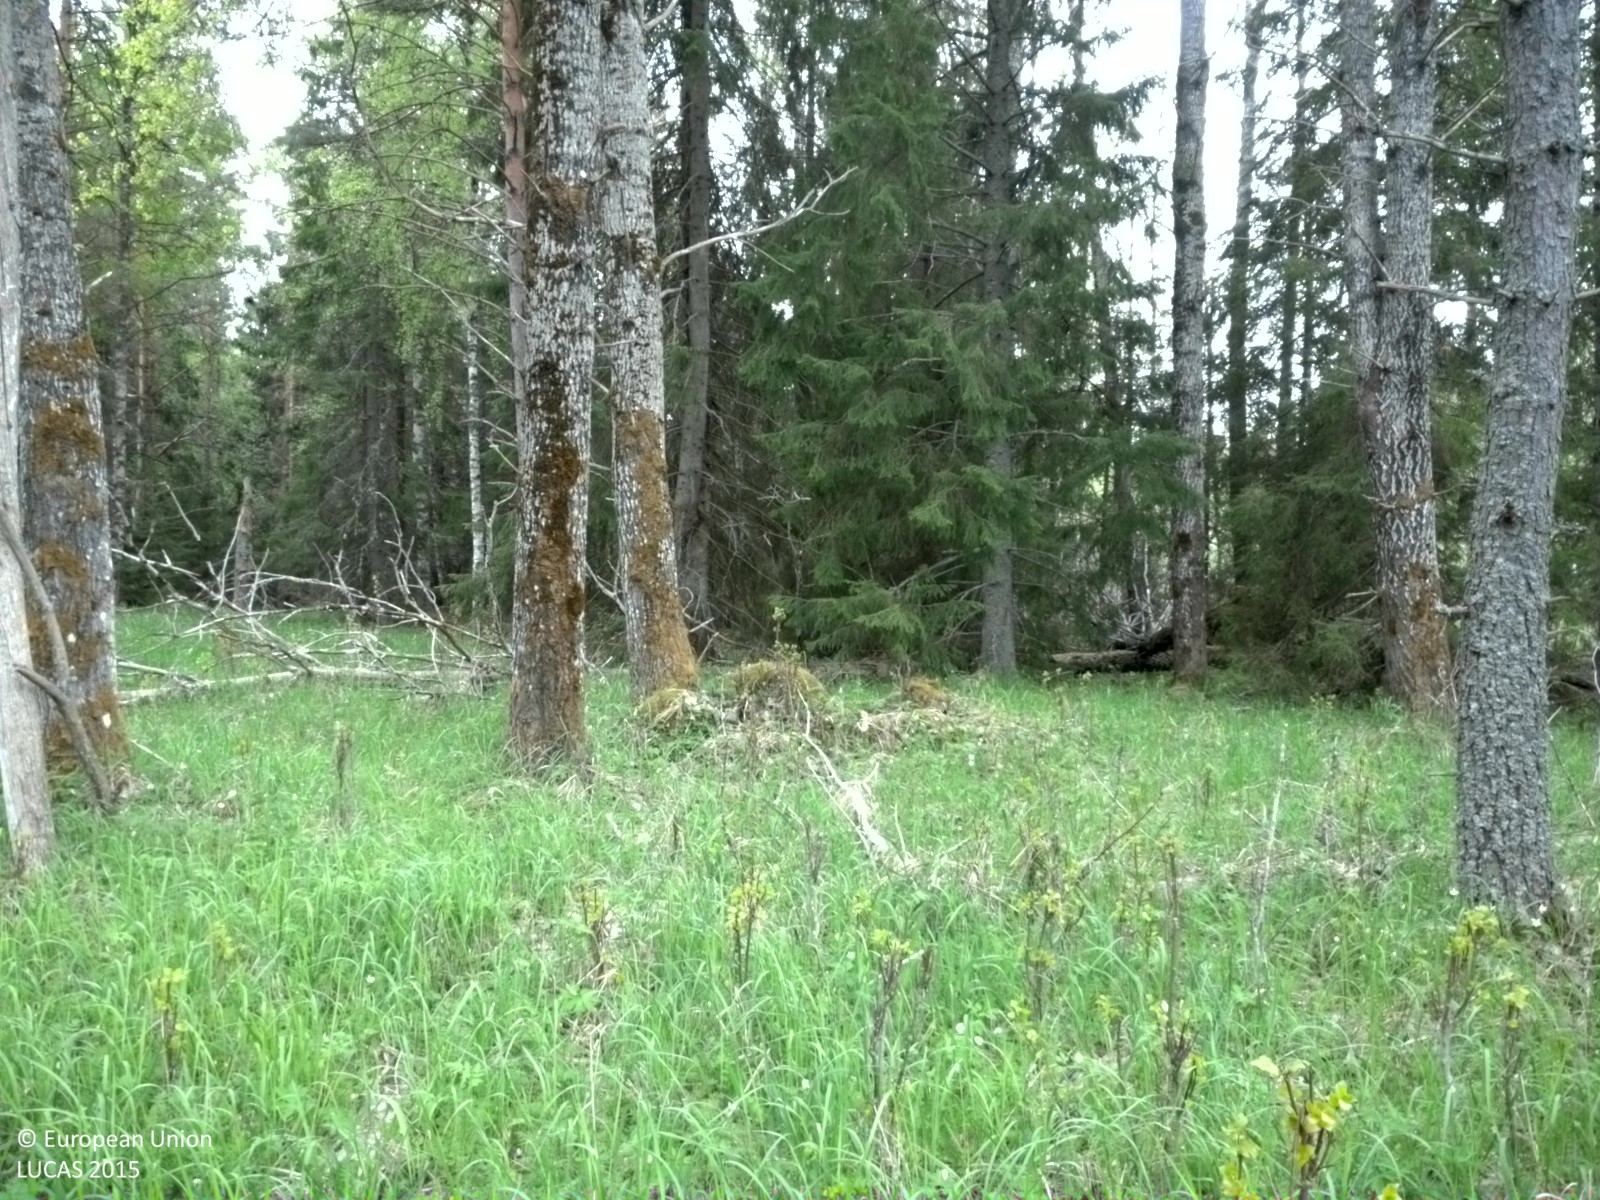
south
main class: Woodland
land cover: Pine dominated coniferous woodland
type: boreal forest
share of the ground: > 75 %
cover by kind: coniferous forest trees 75 %, herbaceous plants 25 %
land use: Forestry
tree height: > 5 m
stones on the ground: < 10 %
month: May
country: SE
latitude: 60.3127
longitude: 18.0489
